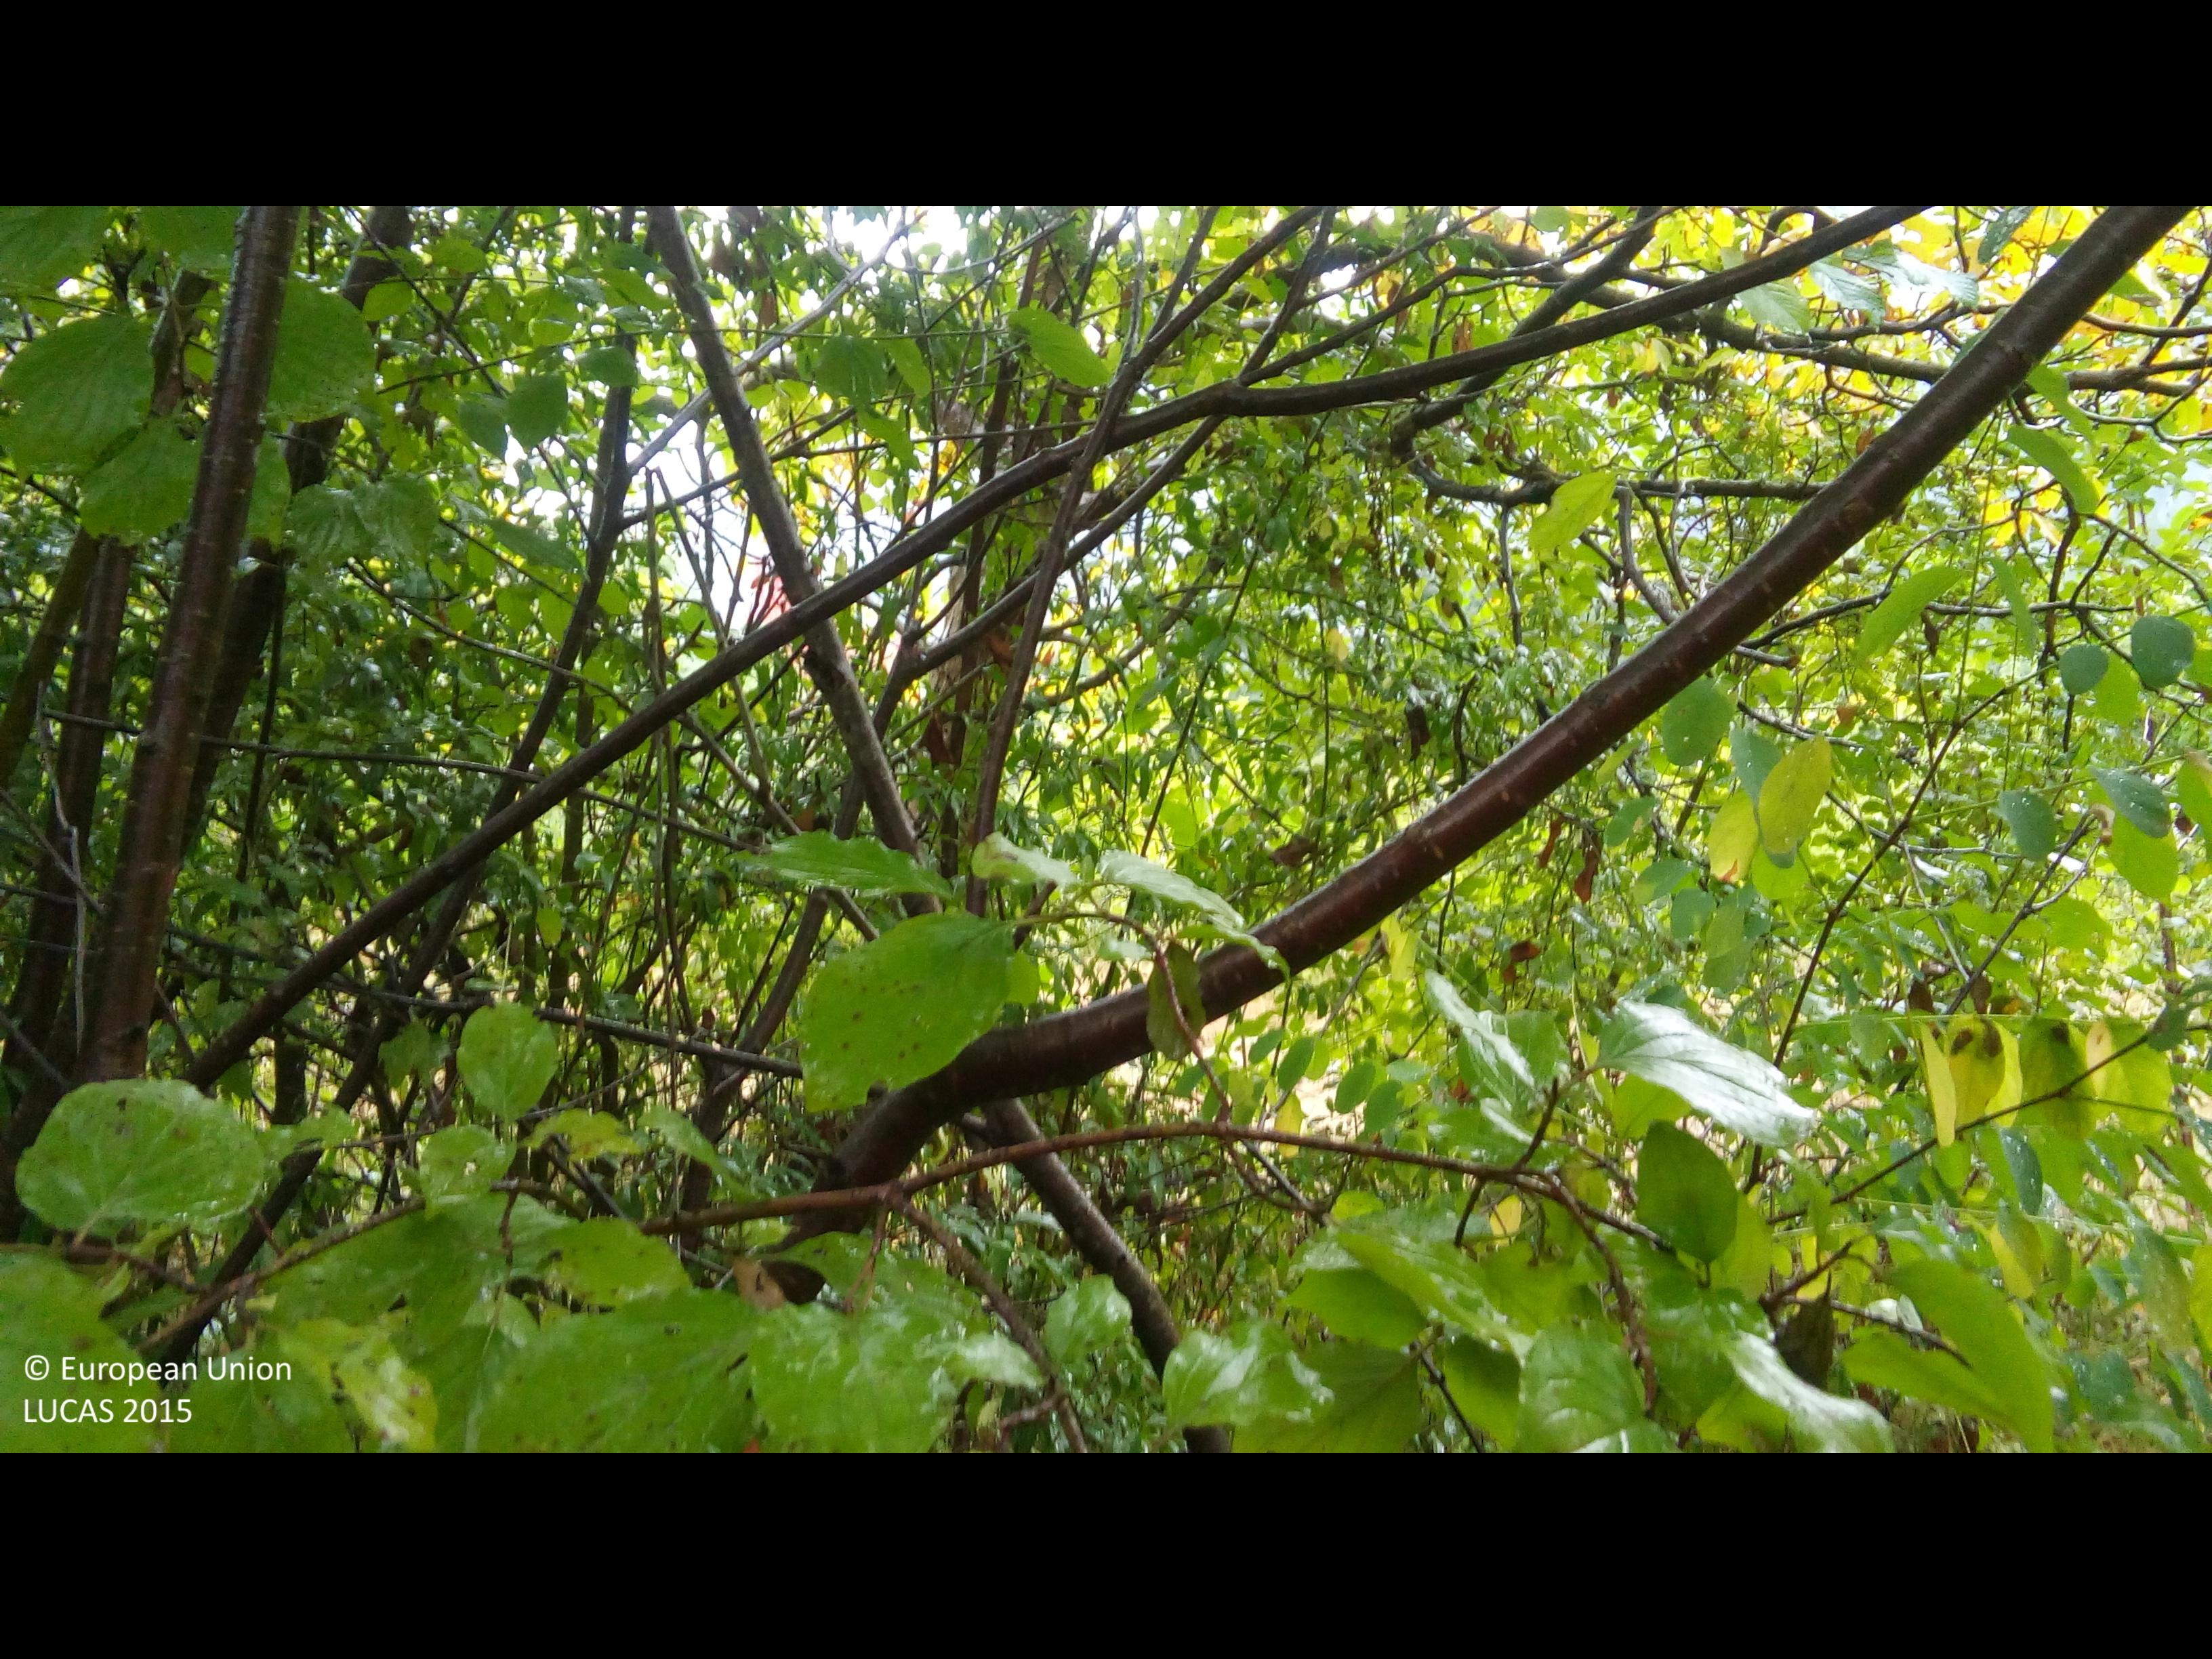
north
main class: Woodland
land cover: Broadleaved woodland
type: beech forest
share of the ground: > 75 %
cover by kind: broadleaved forest trees 90 %, shrubs 5 %, herbaceous plants 5 %
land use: Forestry
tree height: > 5 m
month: October
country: BG
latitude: 42.5784
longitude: 23.4245
